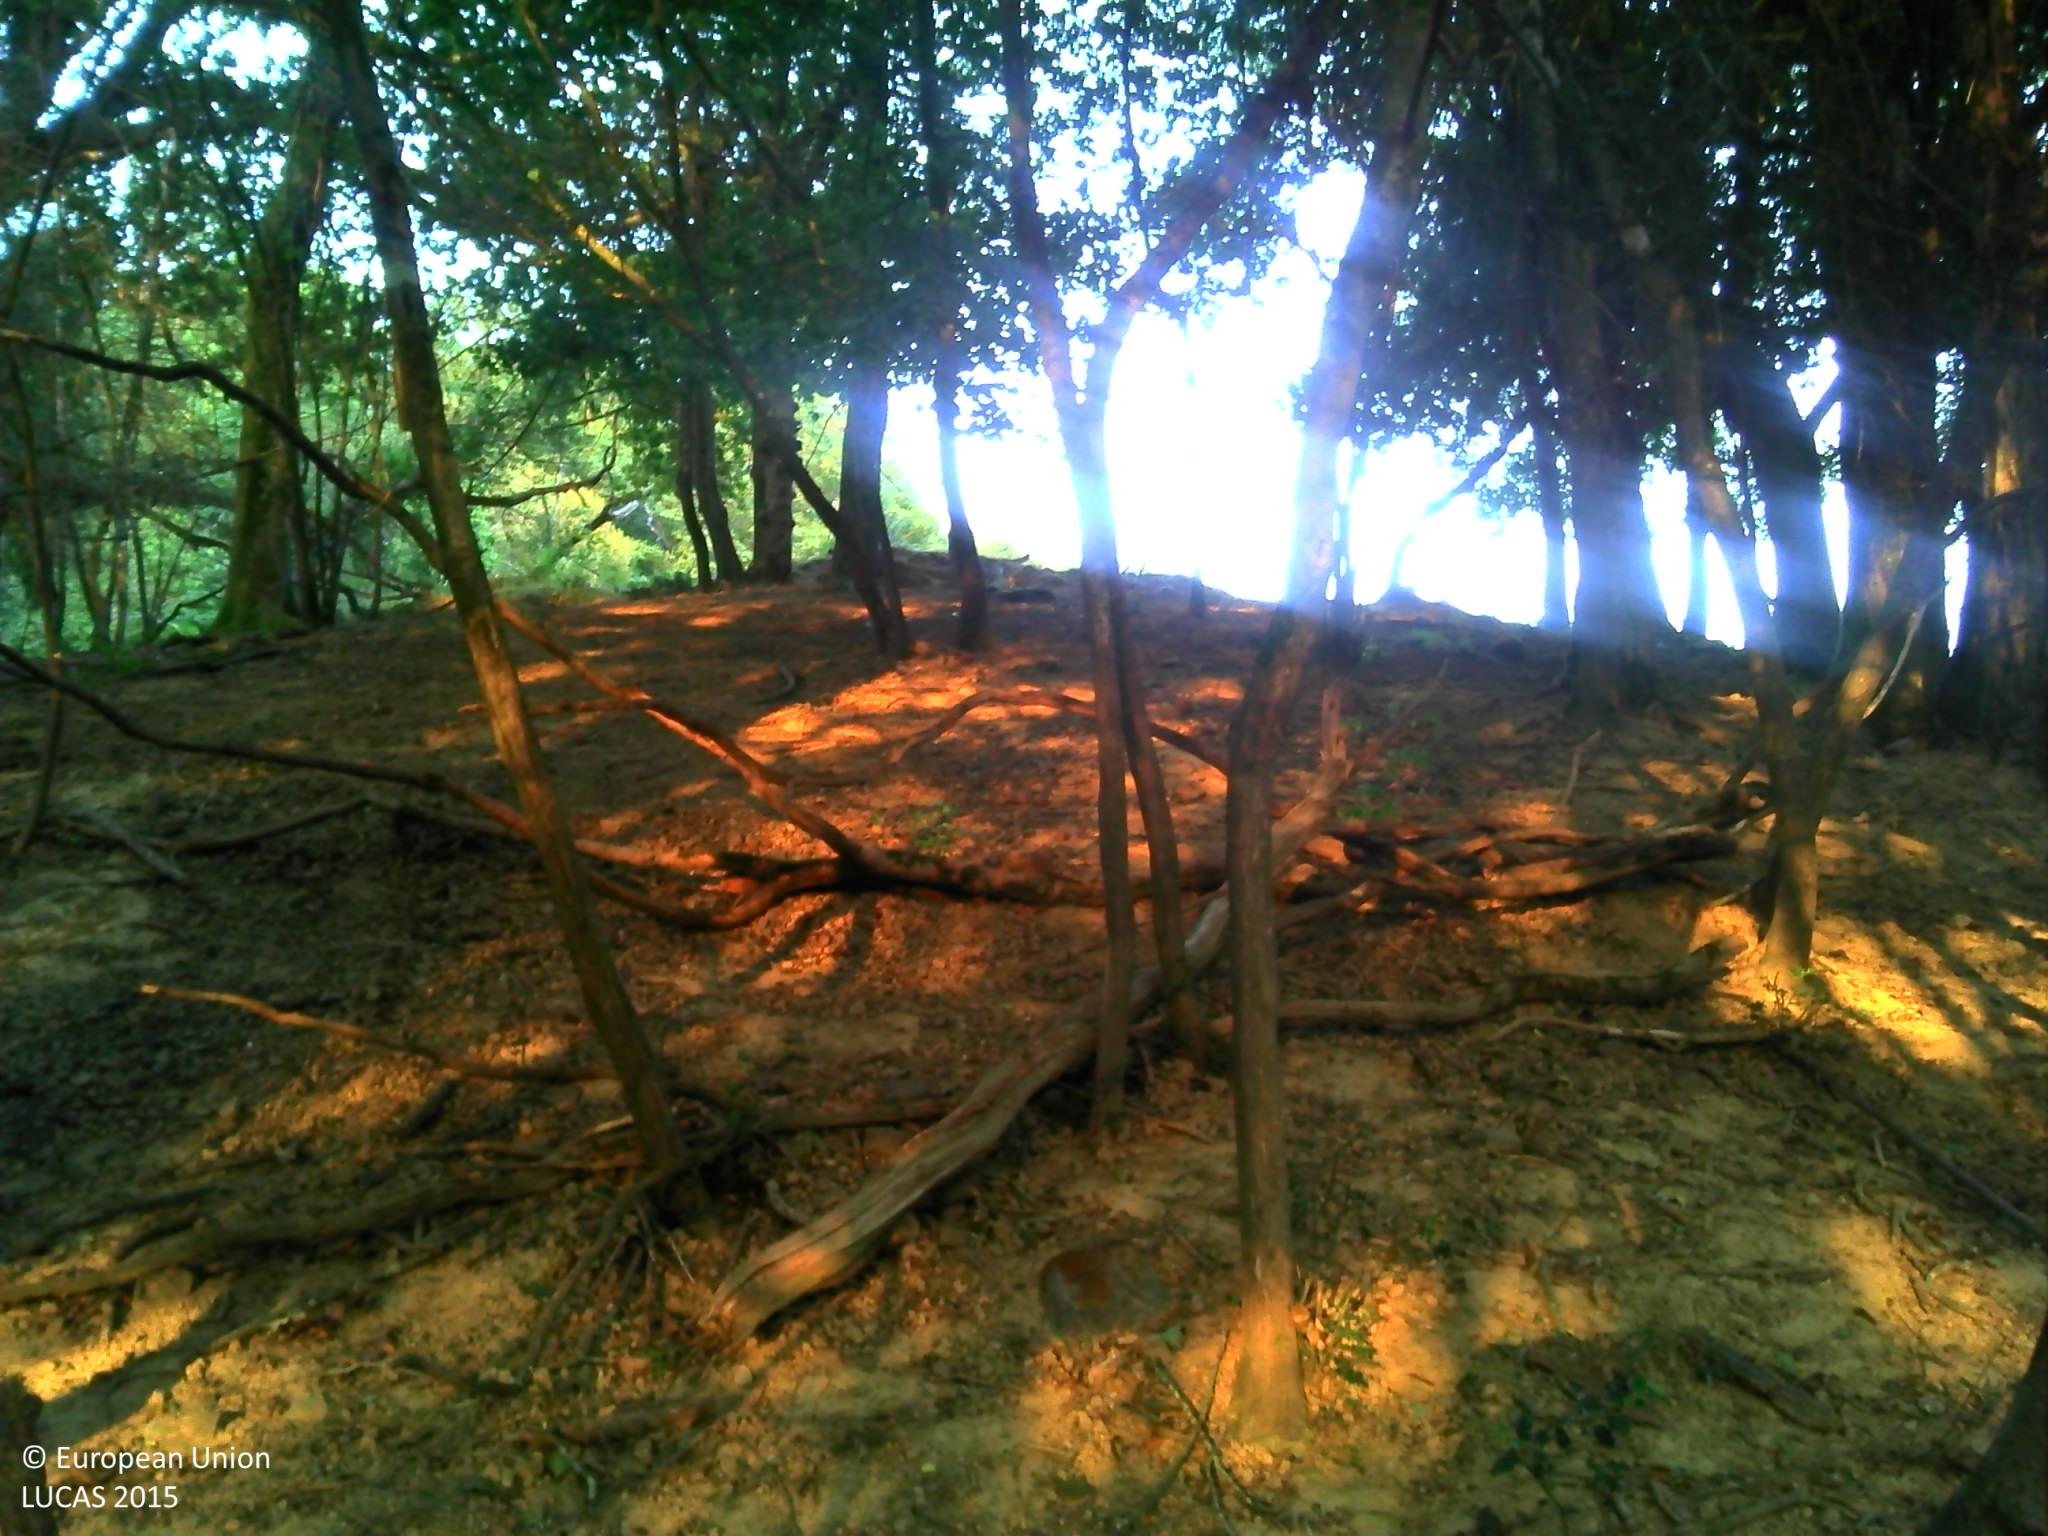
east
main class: Woodland
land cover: Broadleaved woodland
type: thermophilous deciduous forest
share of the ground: > 75 %
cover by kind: broadleaved forest trees 90 %, unconsolidated bare surface 10 %
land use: Forestry
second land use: Agriculture (excluding fallow land and kitchen gardens)
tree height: > 5 m
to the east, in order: Broadleaved woodland; Fences; Broadleaved woodland; Grassland without tree/shrub cover; Broadleaved woodland; Electric lines; Shrubland with sparse tree cover; Fences; Broadleaved woodland; Grassland without tree/shrub cover; Broadleaved woodland
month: August
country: FR
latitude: 43.4289
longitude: -1.0697
